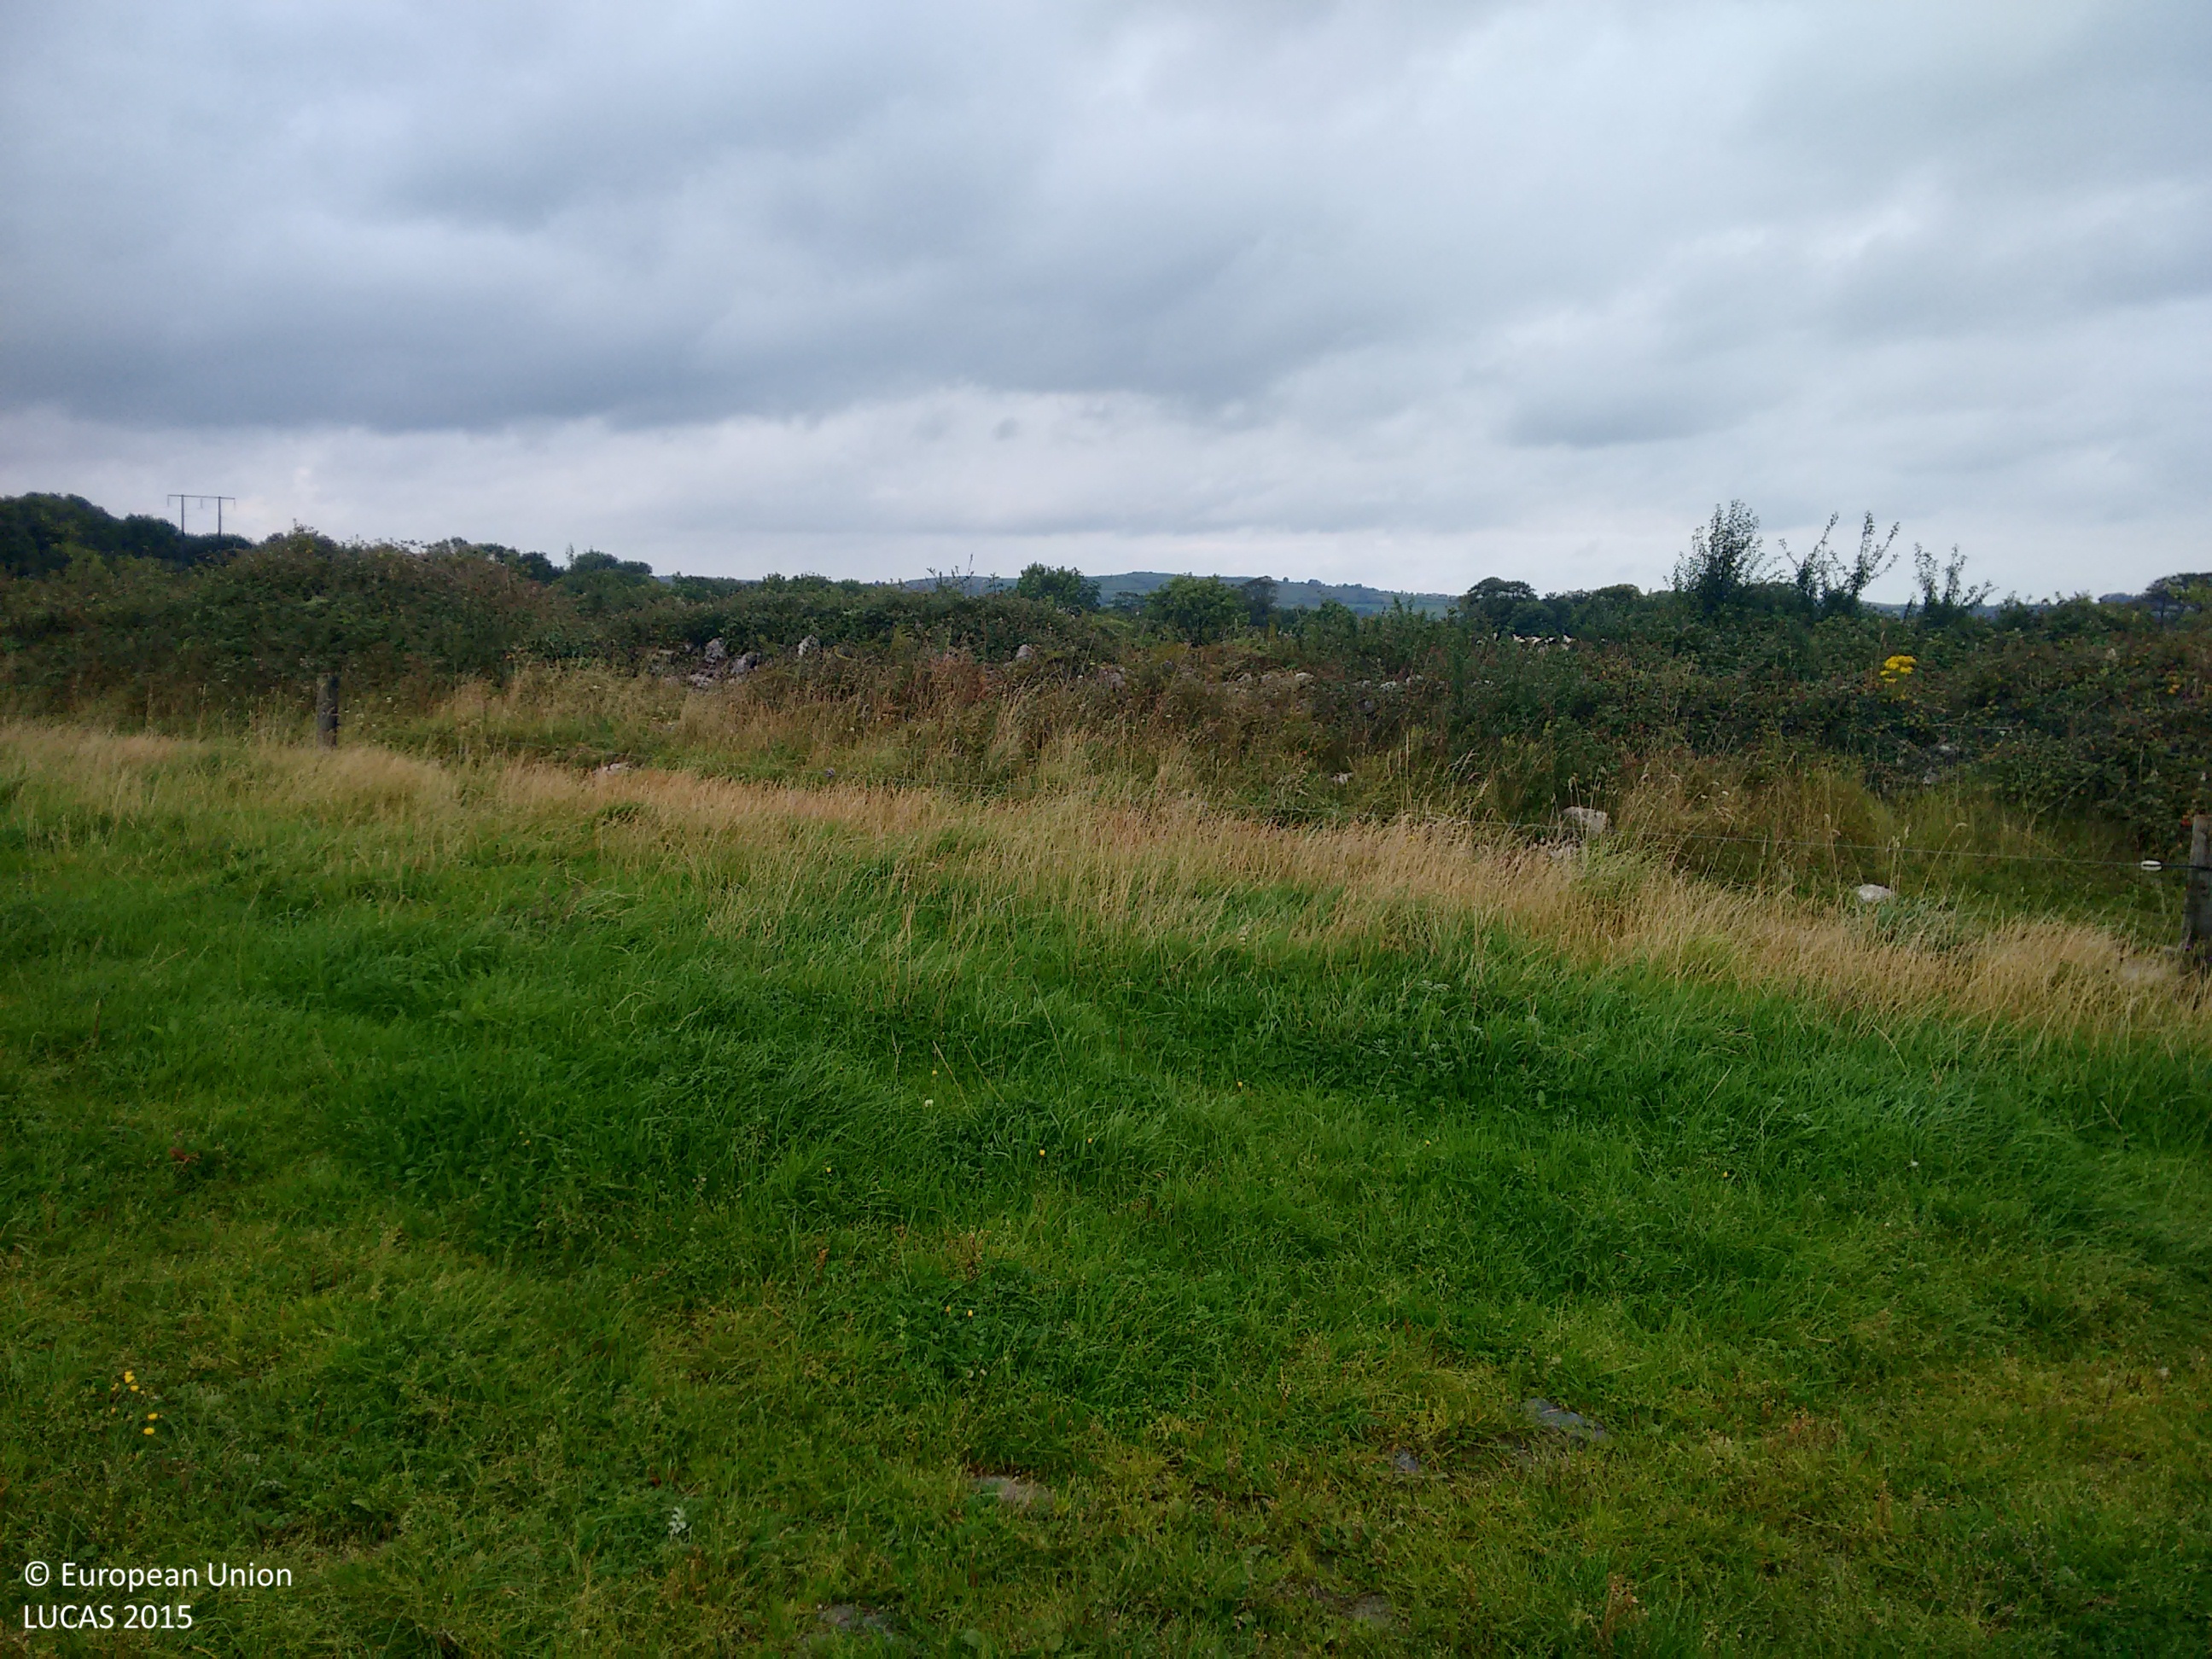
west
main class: Grassland
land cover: Grassland with sparse tree/shrub cover
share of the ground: > 75 %
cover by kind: herbaceous plants 95 %, broadleaved forest trees 5 %
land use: Agriculture (excluding fallow land and kitchen gardens)
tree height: > 5 m
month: September
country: IE
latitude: 52.5703
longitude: -9.0566
